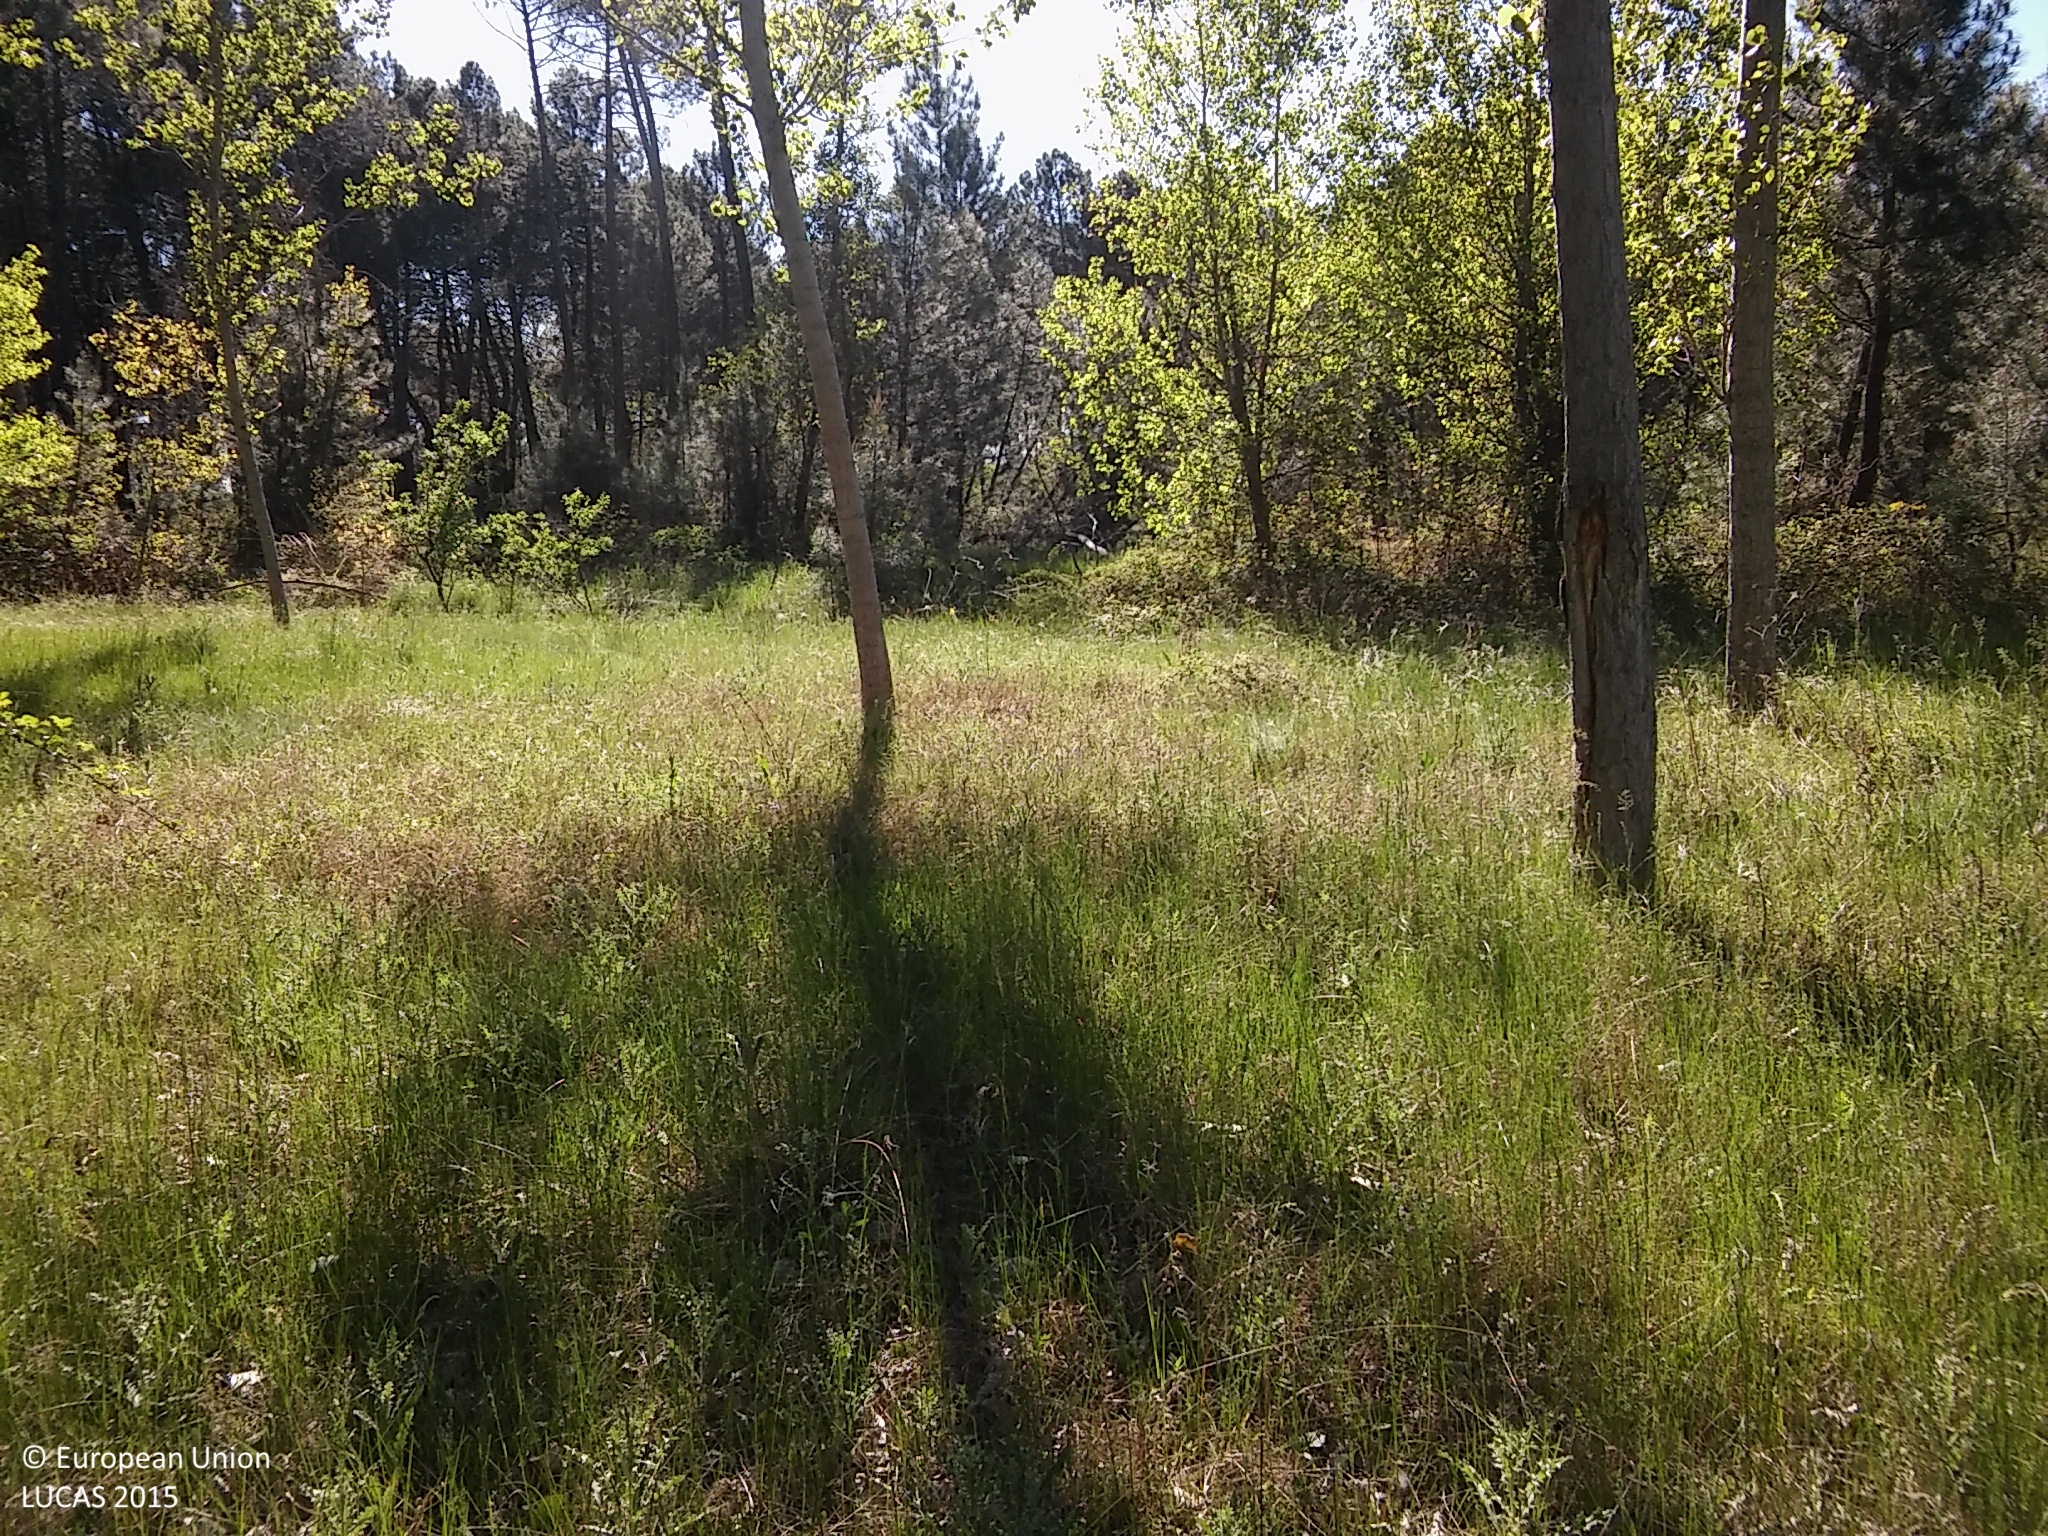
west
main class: Woodland
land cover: Broadleaved woodland
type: exotic forest
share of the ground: 10 - 25 %
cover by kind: herbaceous plants 55 %, broadleaved forest trees 45 %
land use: Forestry
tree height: > 5 m
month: May
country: ES
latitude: 41.3400
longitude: -4.0477
